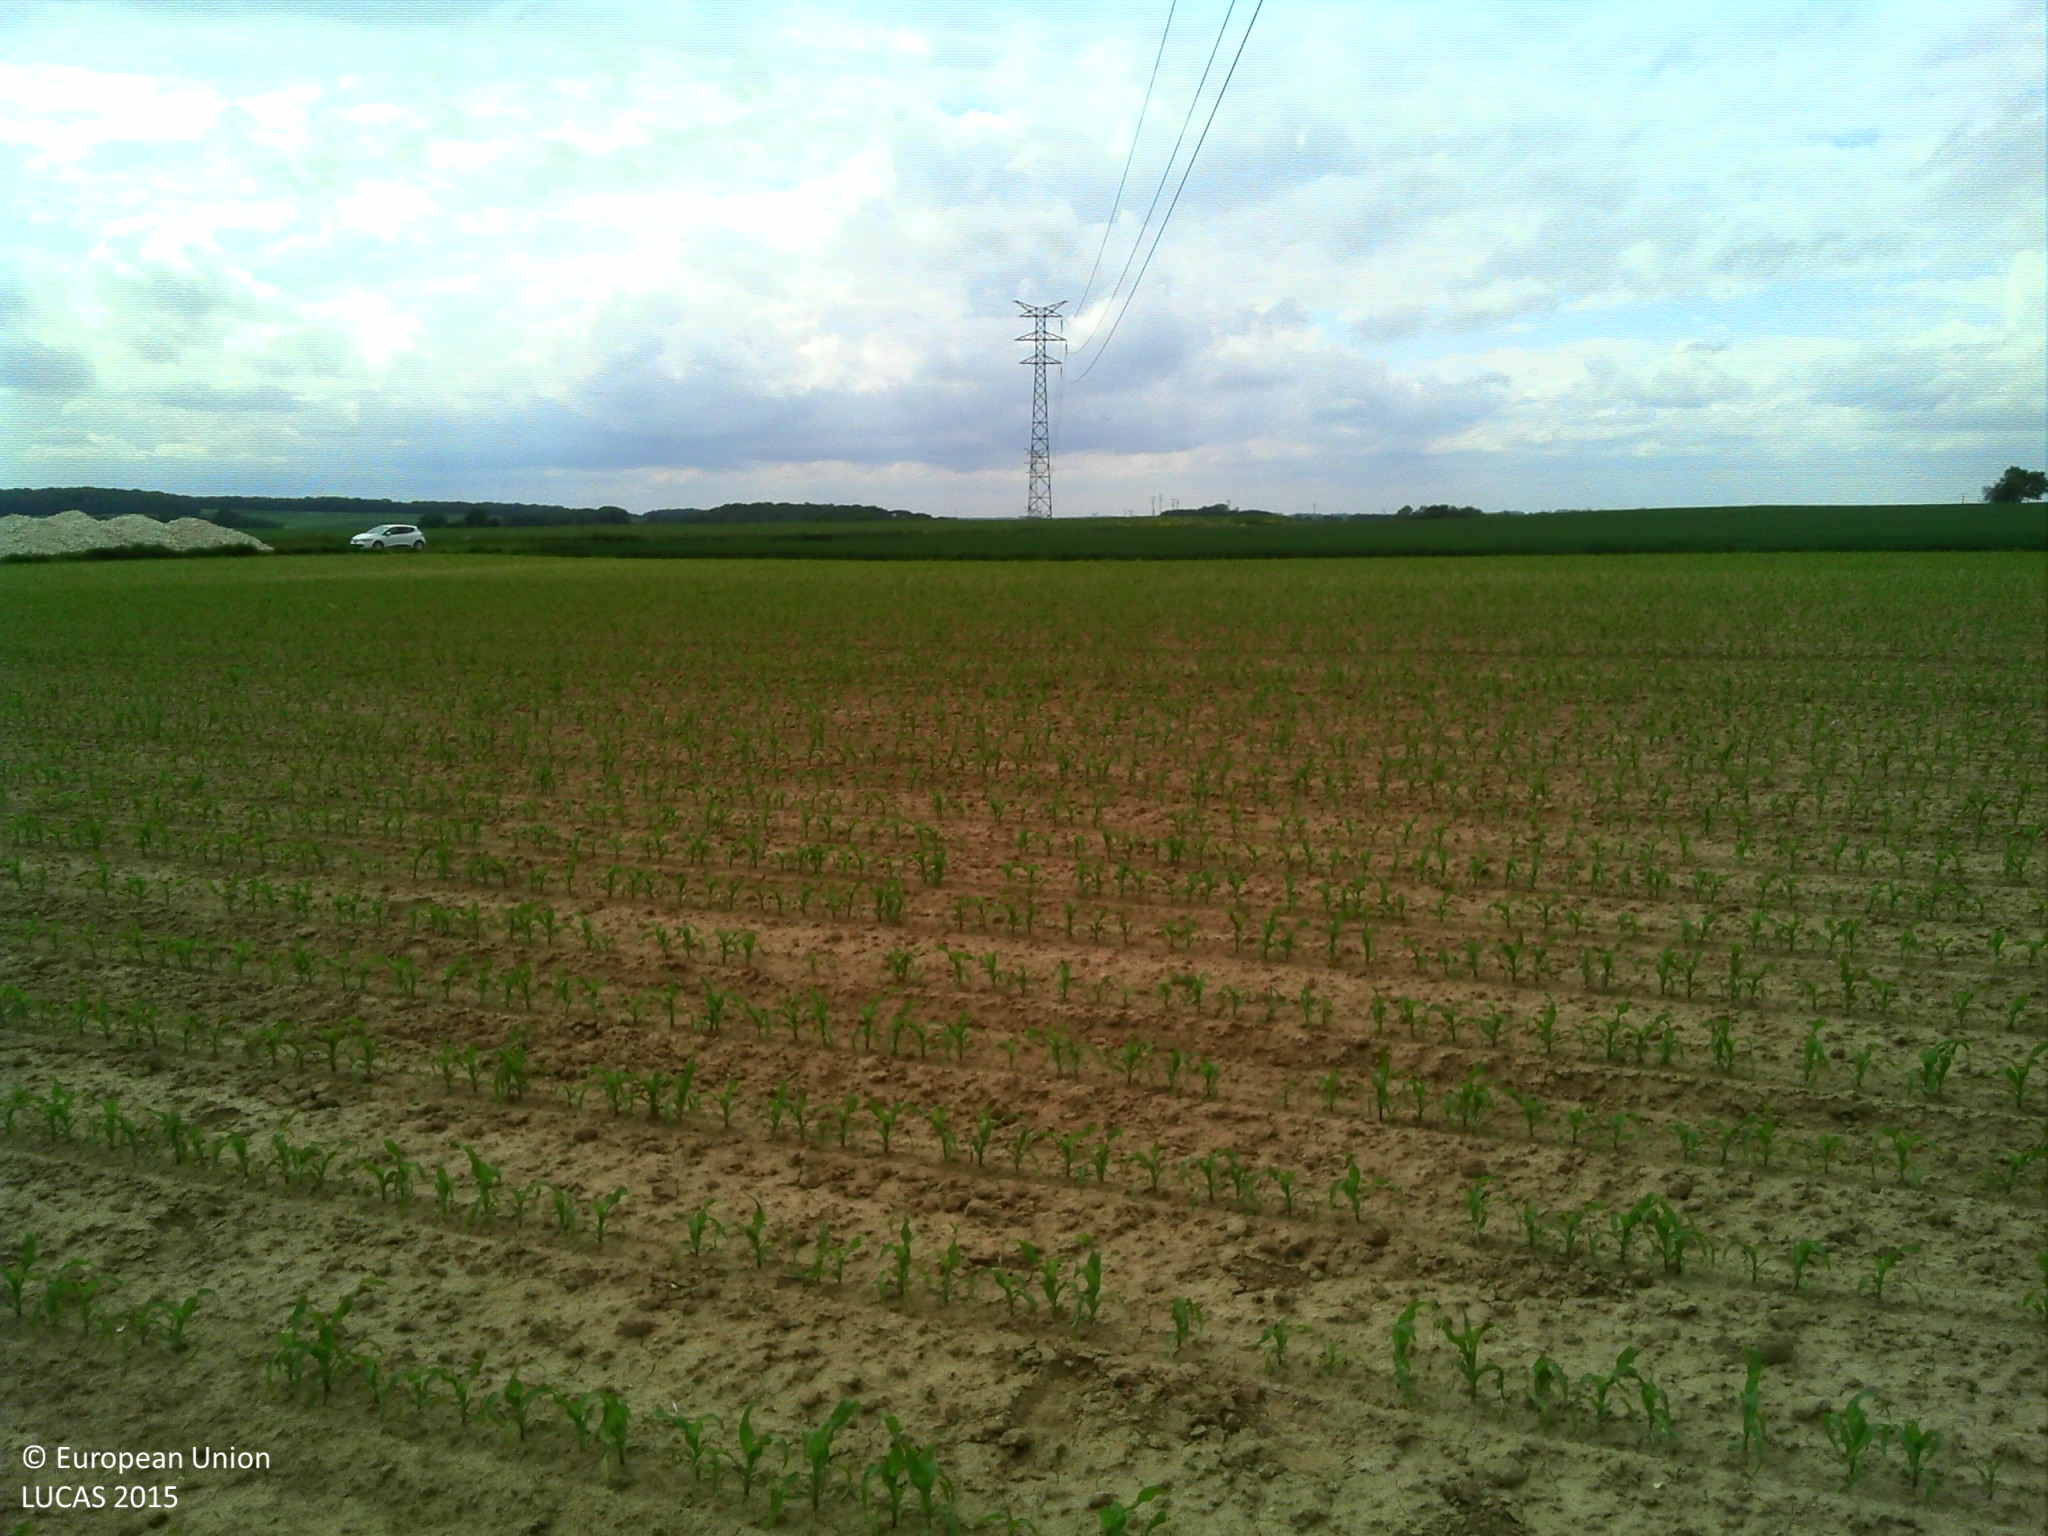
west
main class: Cropland
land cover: Maize
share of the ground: < 10 %
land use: Agriculture (excluding fallow land and kitchen gardens)
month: May
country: FR
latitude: 49.8754
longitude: 3.2426
